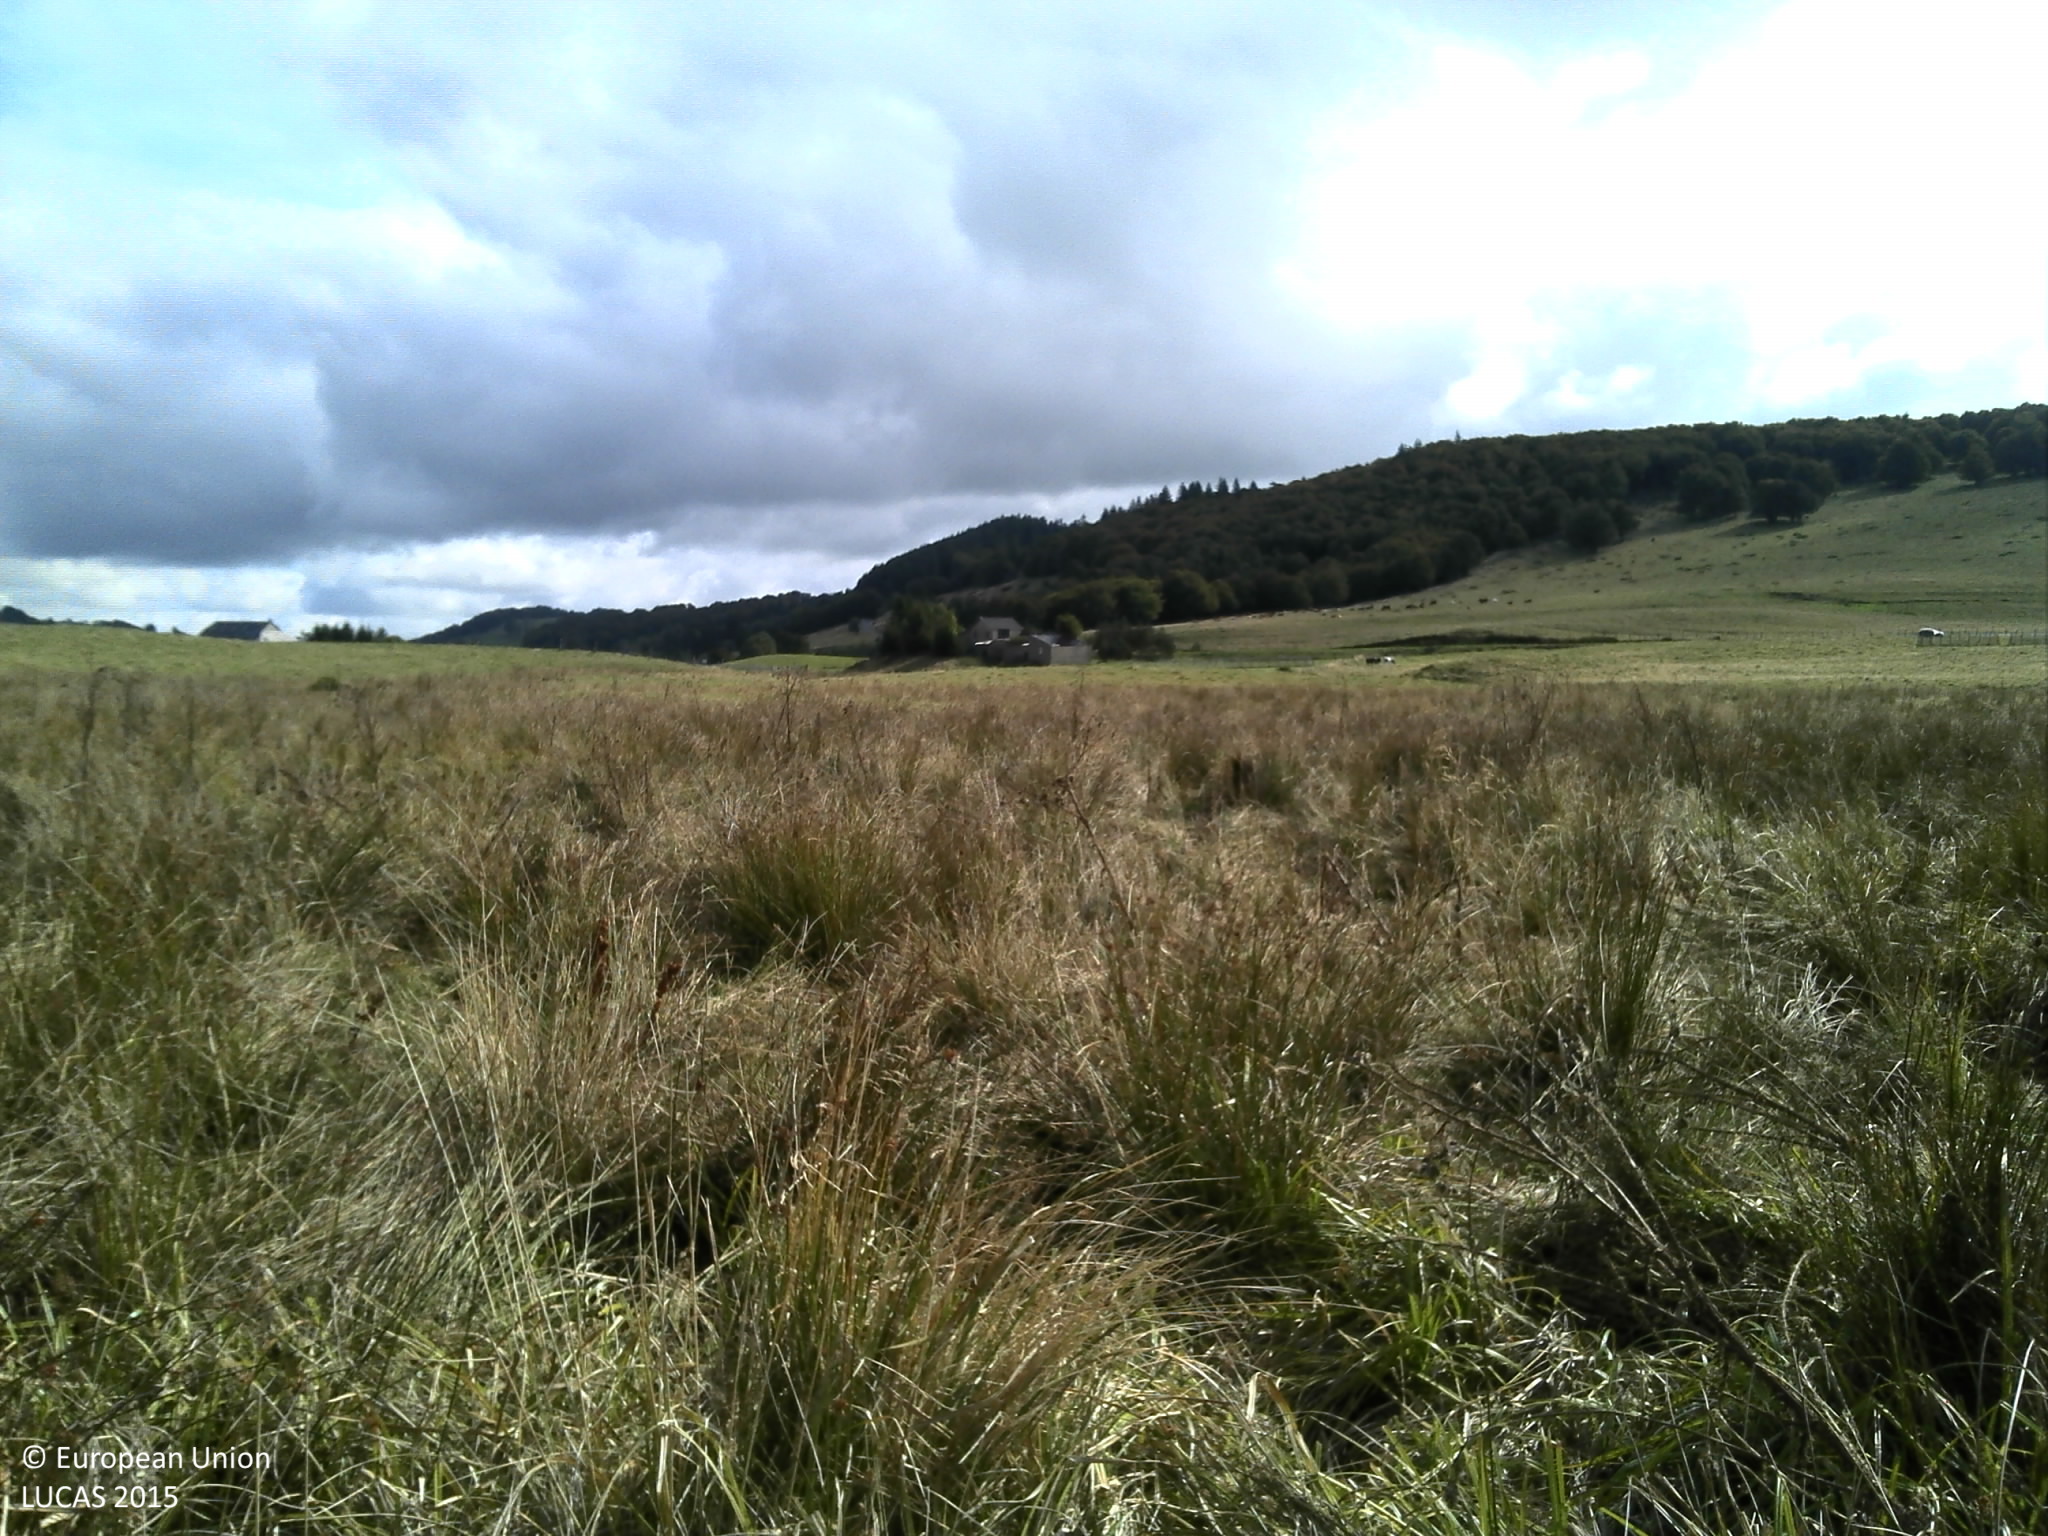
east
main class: Grassland
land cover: Grassland without tree/shrub cover
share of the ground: > 75 %
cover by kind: herbaceous plants 100 %
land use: Agriculture (excluding fallow land and kitchen gardens)
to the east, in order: Grassland without tree/shrub cover; Tracks; Grassland without tree/shrub cover; Fences; Tracks; Grassland without tree/shrub cover
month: September
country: FR
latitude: 45.4984
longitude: 2.8718
